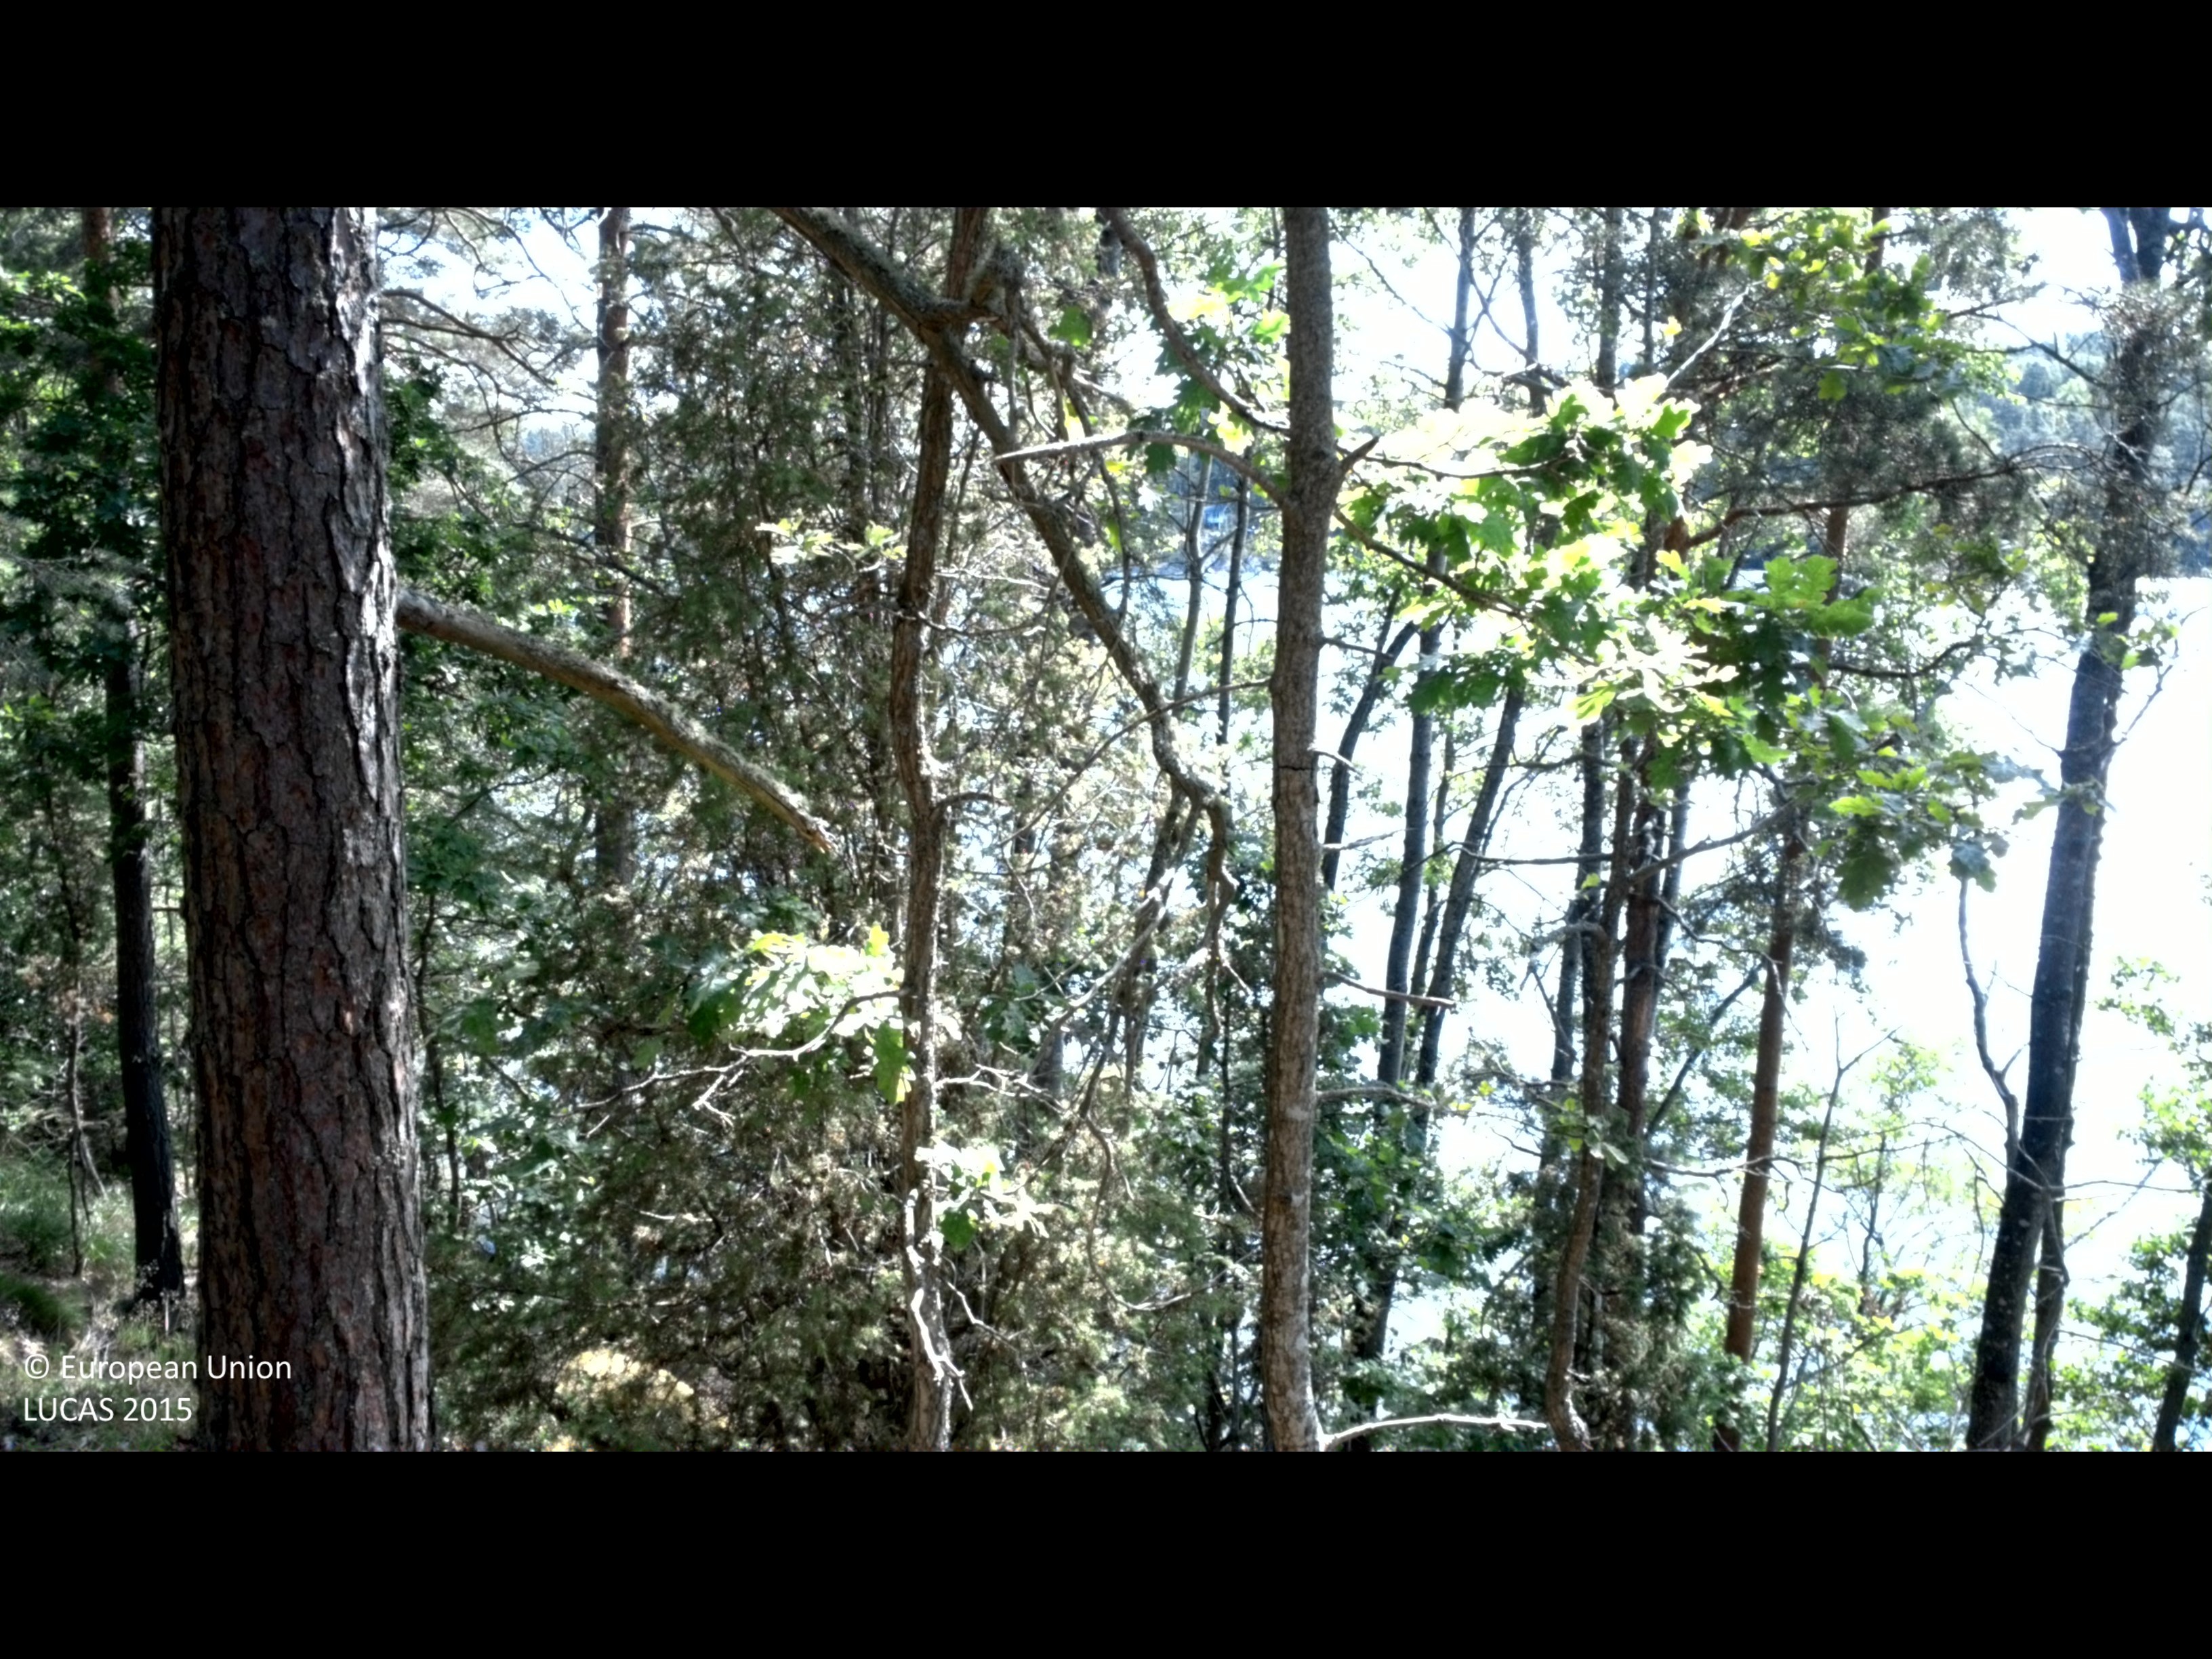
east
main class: Woodland
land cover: Pine dominated mixed woodland
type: boreal forest
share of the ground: 50 - 75 %
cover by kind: coniferous forest trees 40 %, broadleaved forest trees 30 %, shrubs 15 %, lichens and mosses 10 %, herbaceous plants 5 %
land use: Forestry
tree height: > 5 m
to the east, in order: Pine dominated mixed woodland; Inland fresh water bodies
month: July
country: SE
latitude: 58.2662
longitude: 16.3888
